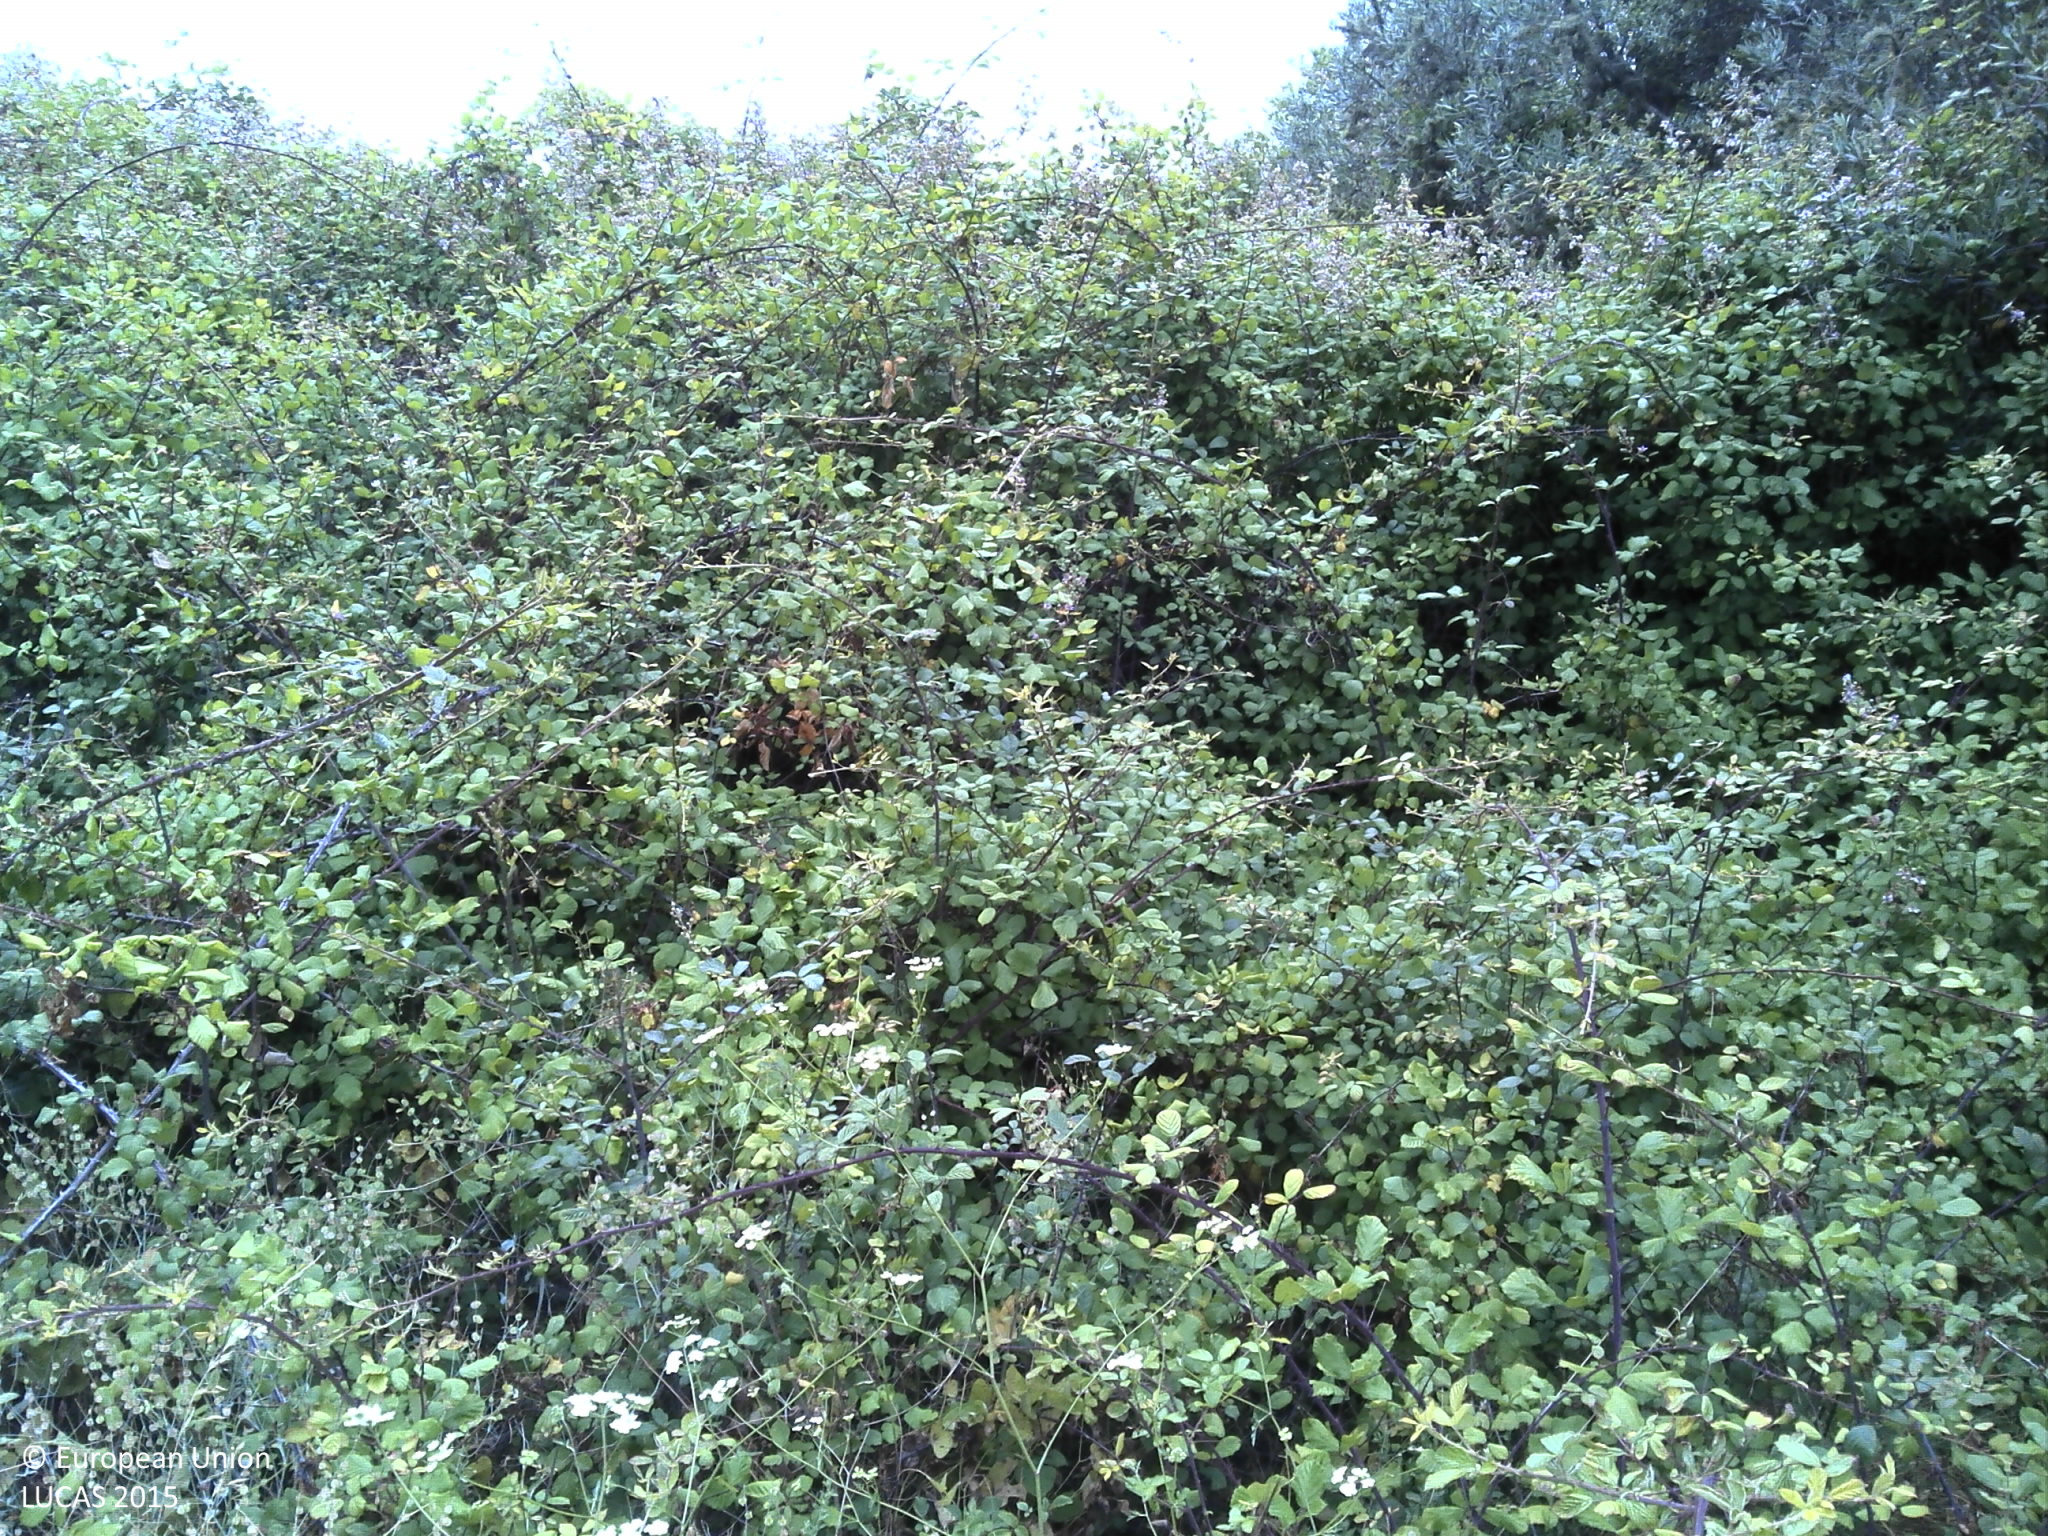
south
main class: Cropland
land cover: Olive groves
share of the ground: 25 - 50 %
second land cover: Shrubland without tree cover
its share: 50 - 75 %
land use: Agriculture (excluding fallow land and kitchen gardens)
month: June
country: PT
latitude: 37.3462
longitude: -7.8148
